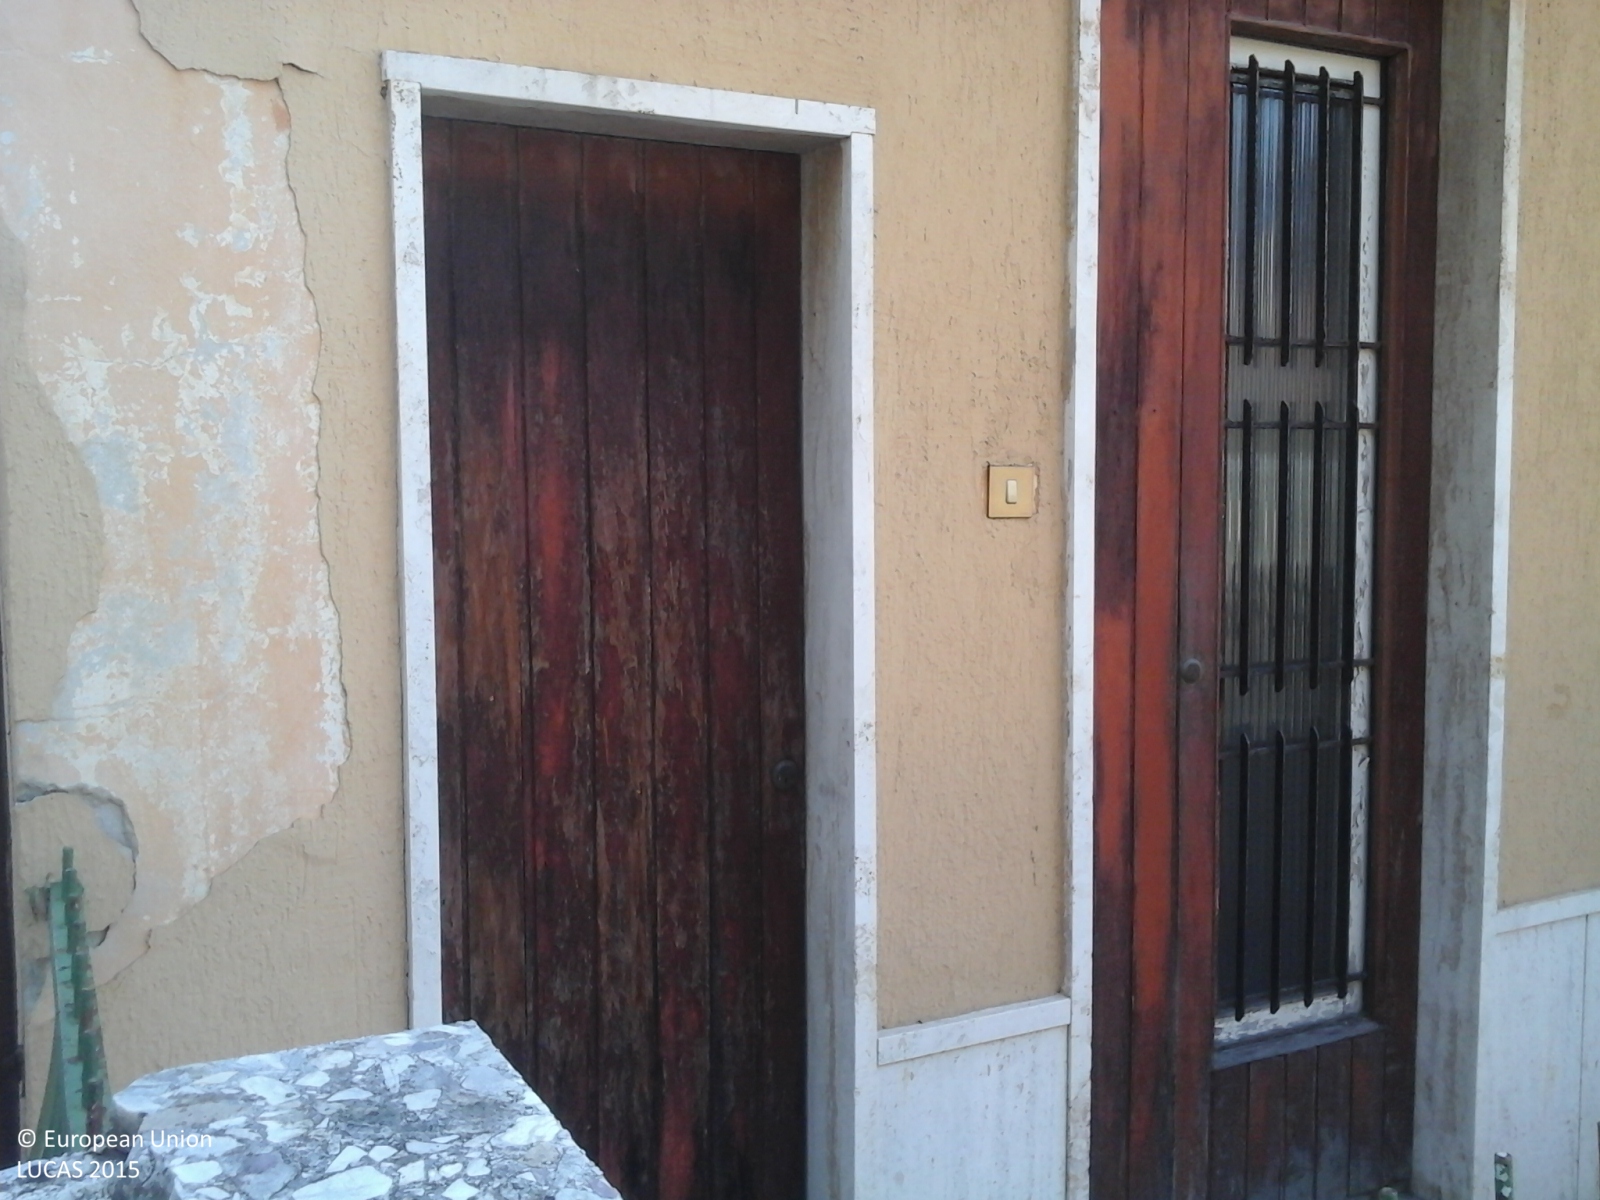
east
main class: Woodland
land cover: Broadleaved woodland
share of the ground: > 75 %
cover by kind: broadleaved forest trees 50 %, herbaceous plants 40 %, shrubs 10 %
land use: Community services
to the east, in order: Broadleaved woodland; Artificial constructions in urban areas
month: August
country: IT
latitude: 43.8270
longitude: 10.2852
